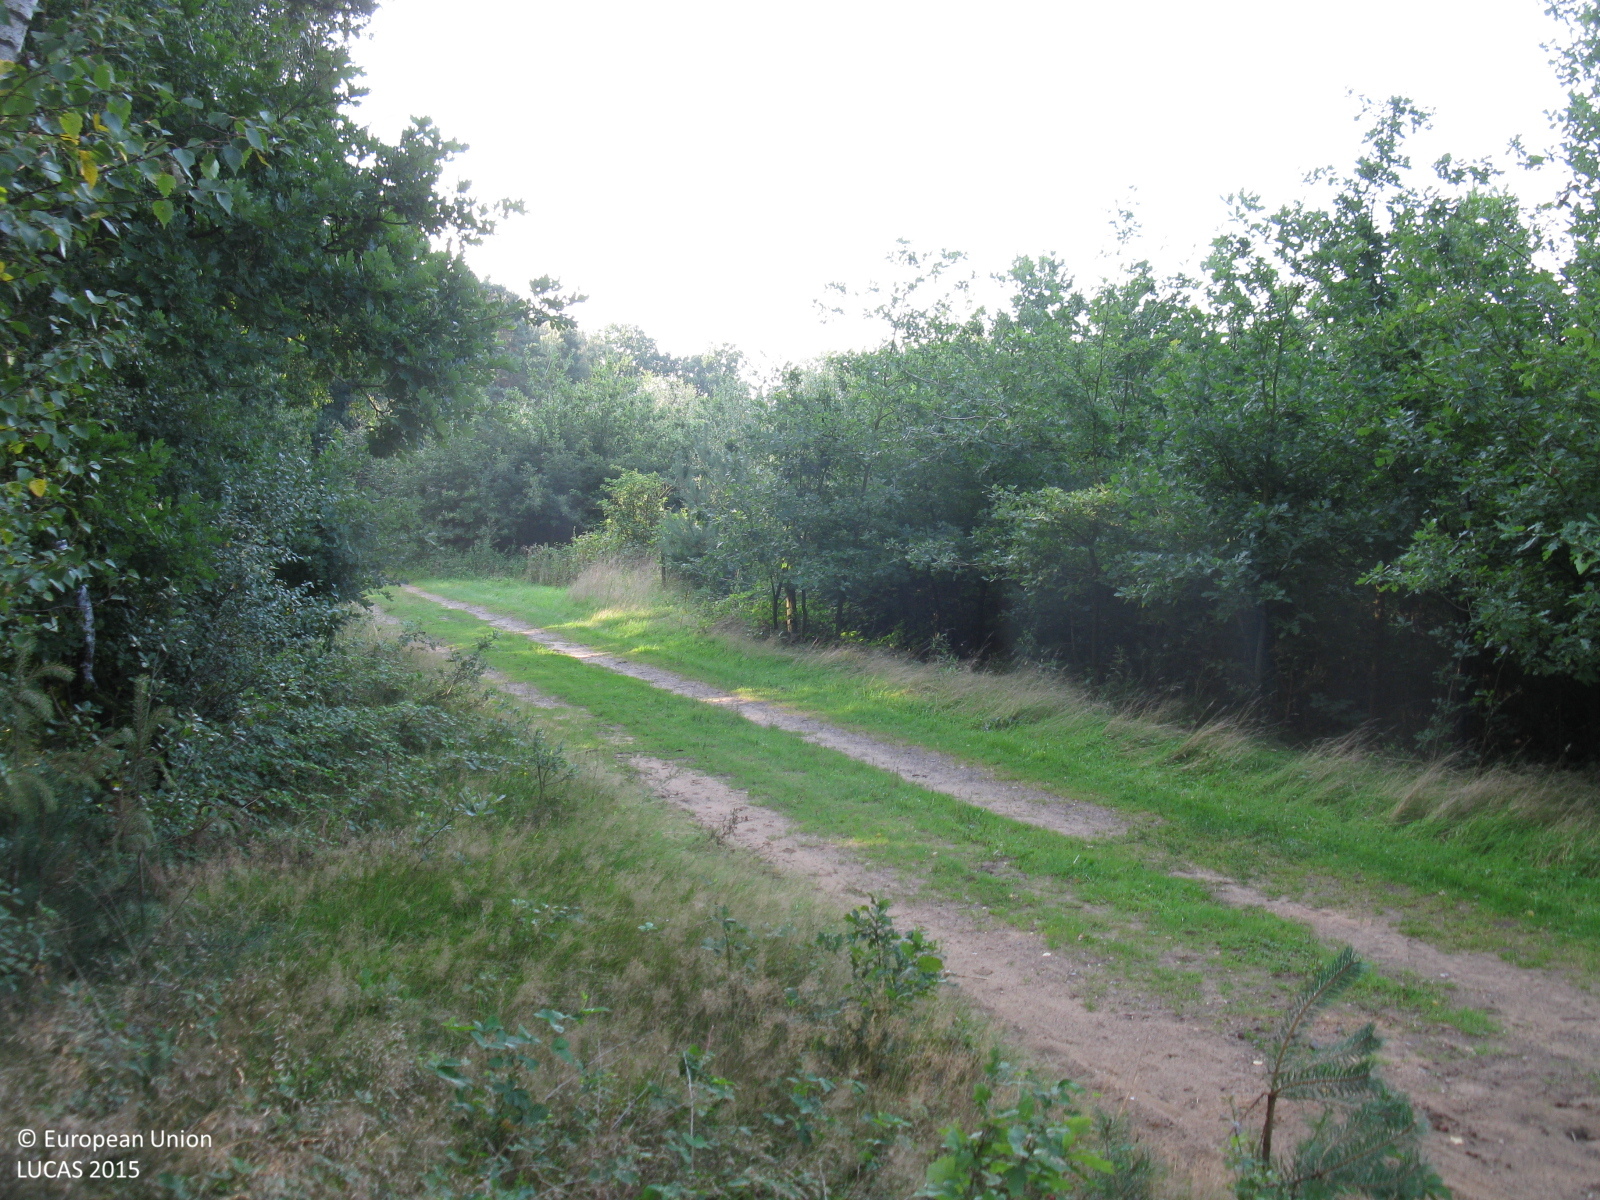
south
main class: Woodland
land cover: Pine dominated mixed woodland
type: hemiboreal forest and nemoral coniferous forest and mixed broadleaved-coniferous forest
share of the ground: > 75 %
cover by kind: coniferous forest trees 50 %, broadleaved forest trees 50 %
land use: Forestry
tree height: > 5 m
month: August
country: DE
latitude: 51.8523
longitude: 6.9367
